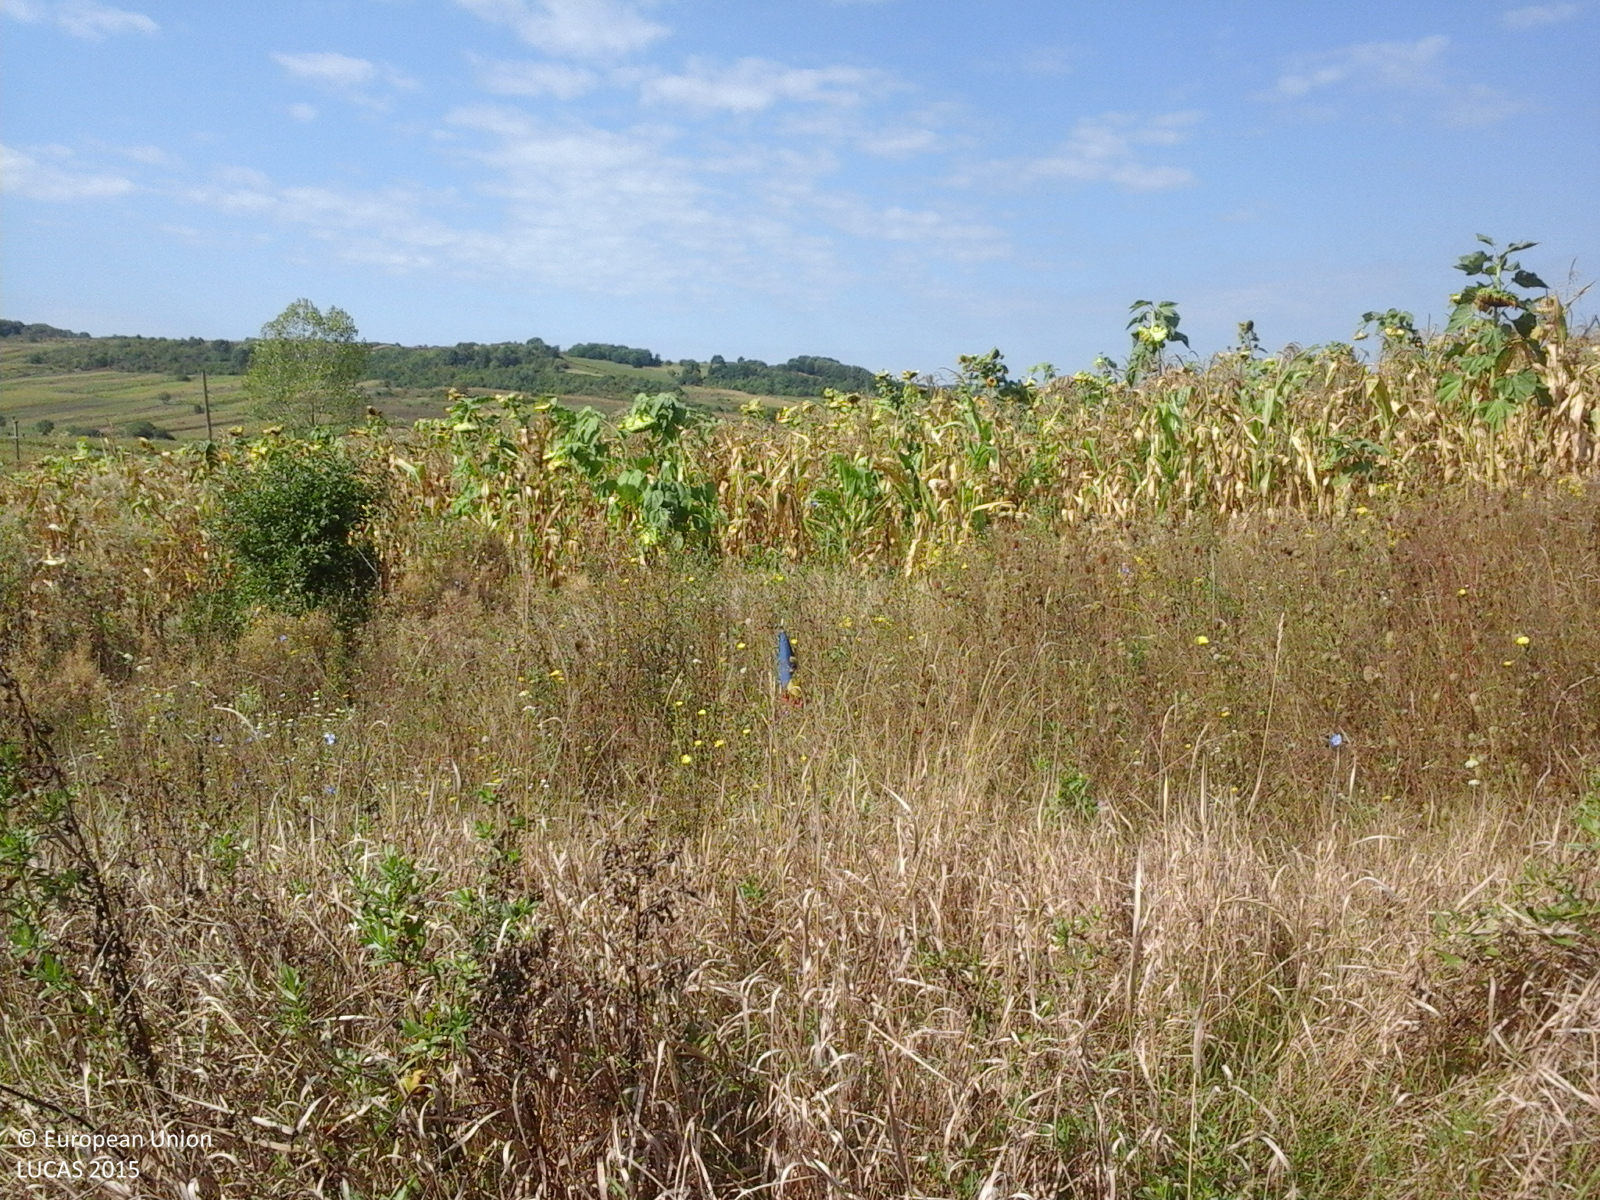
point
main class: Grassland
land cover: Spontaneously vegetated surfaces
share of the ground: > 75 %
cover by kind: herbaceous plants 100 %
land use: Fallow land
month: September
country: RO
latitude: 47.3574
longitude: 23.1608
